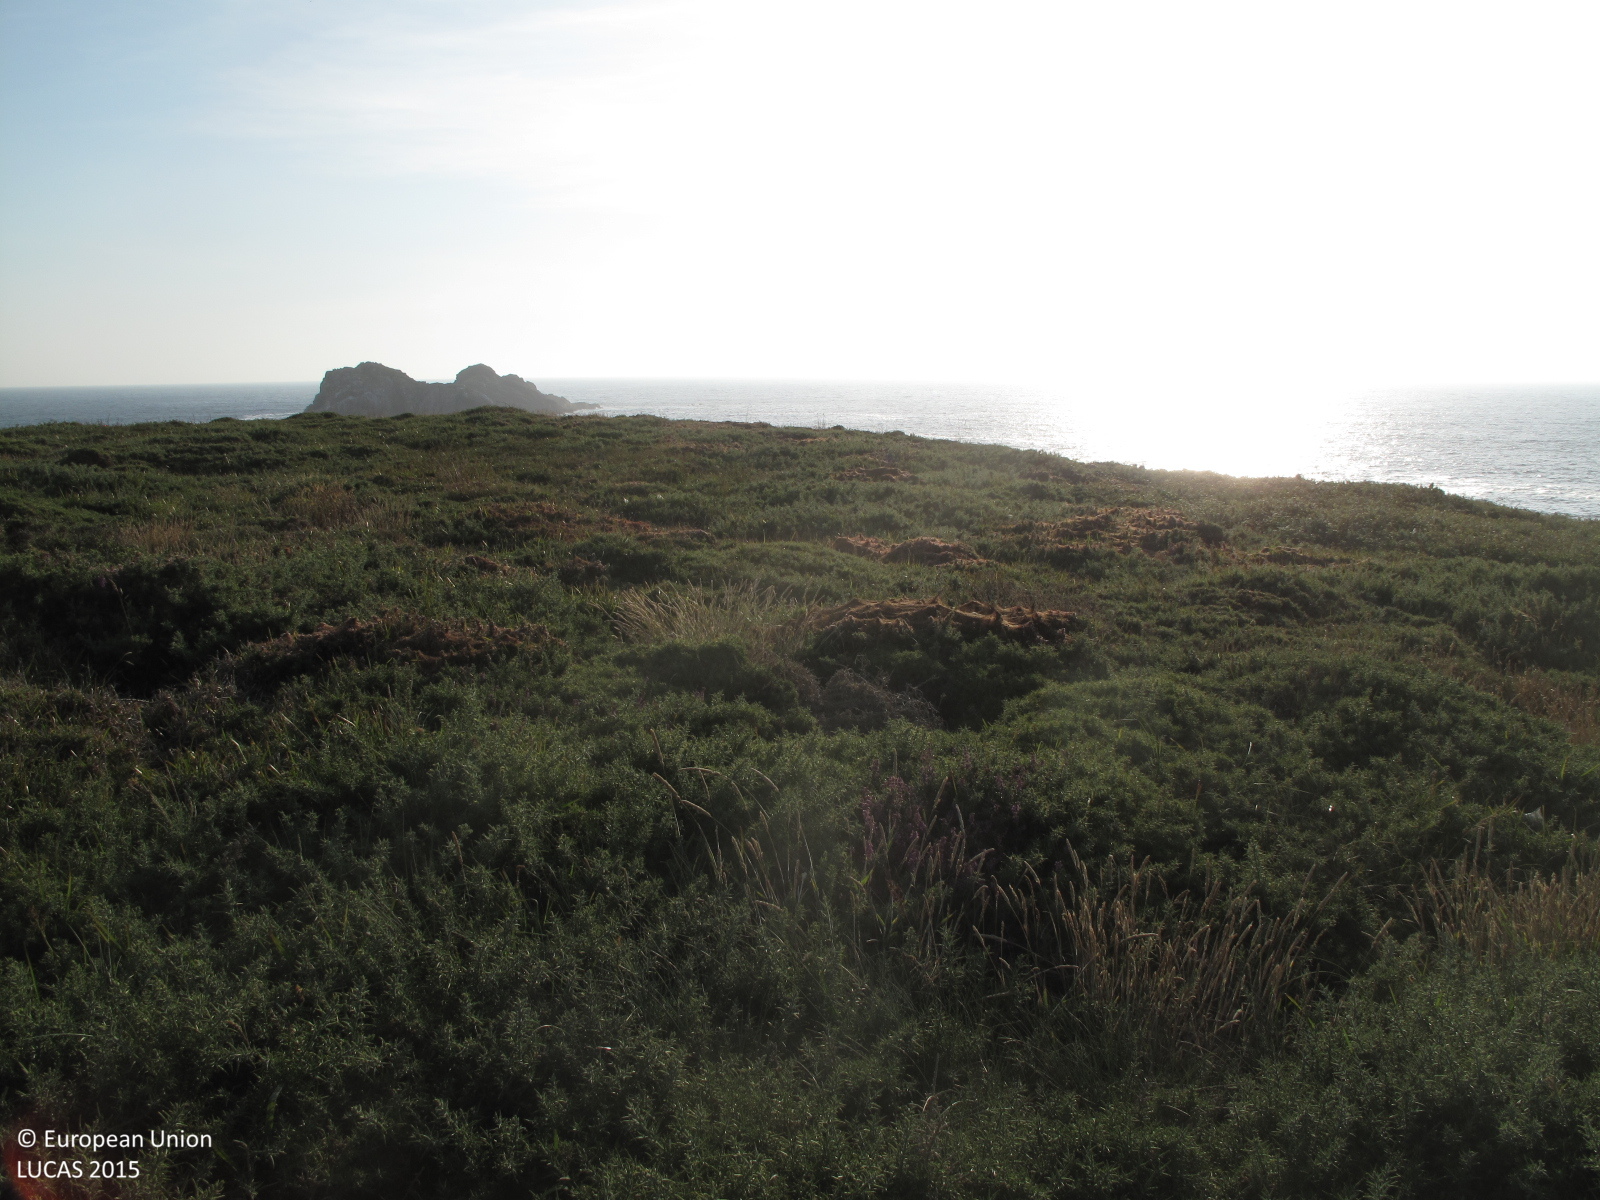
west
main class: Shrubland
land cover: Shrubland without tree cover
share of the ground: > 75 %
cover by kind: shrubs 100 %
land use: Semi-natural and natural areas not in use
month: July
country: ES
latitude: 43.5132
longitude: -8.3275
